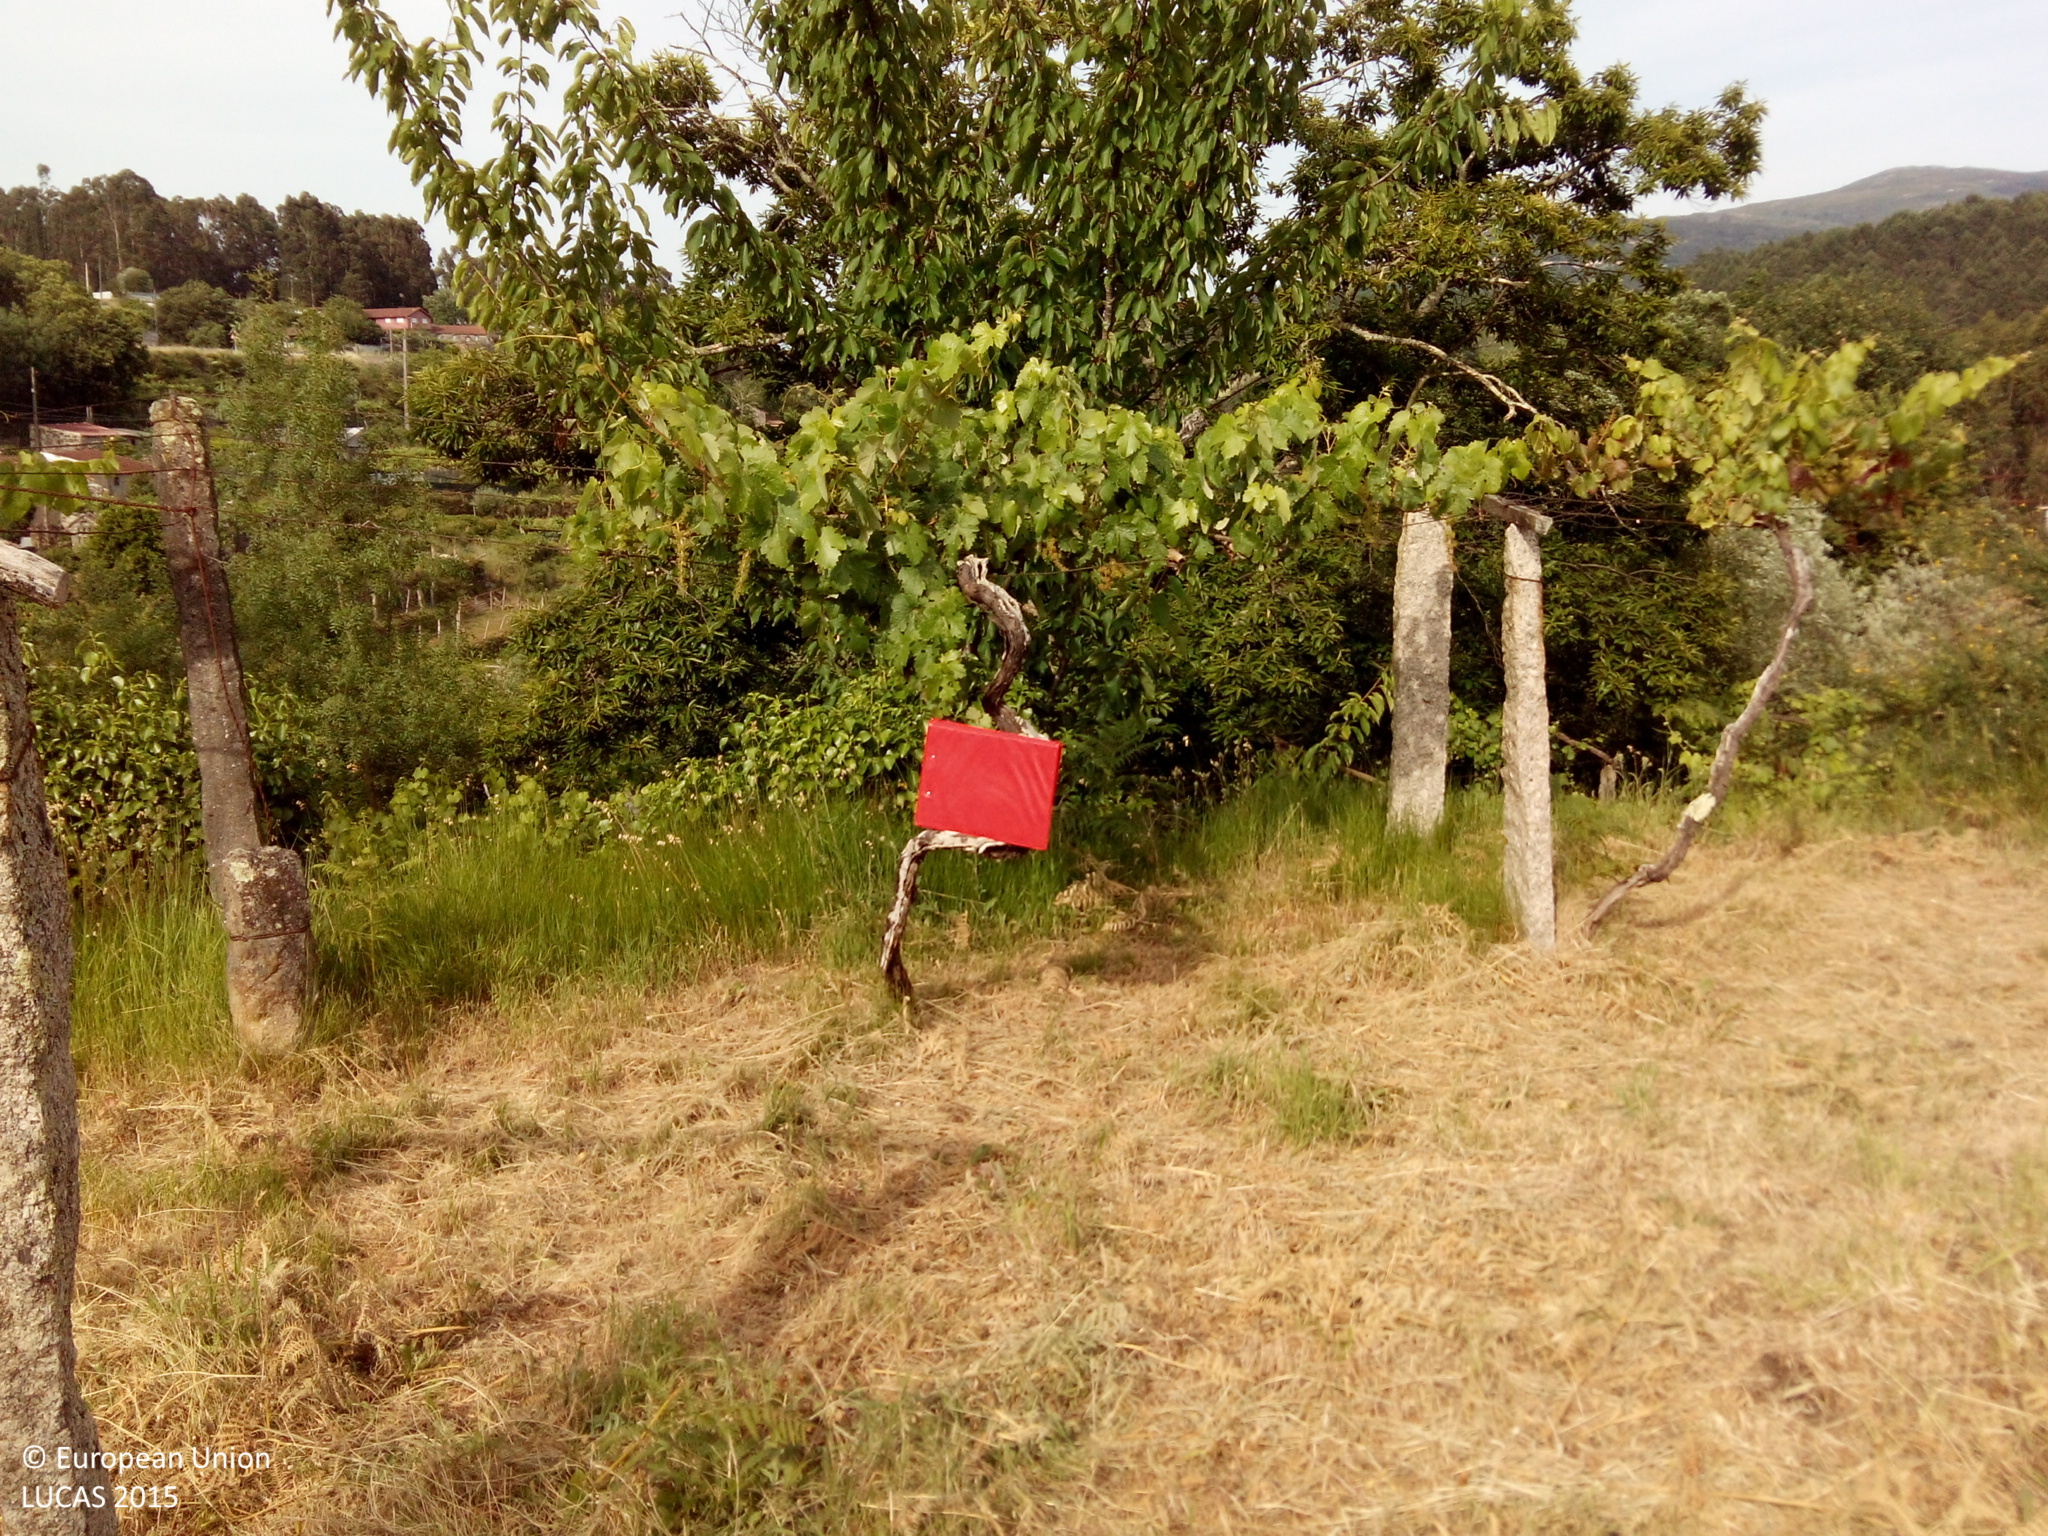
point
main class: Cropland
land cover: Vineyards
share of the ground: 50 - 75 %
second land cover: Grassland without tree/shrub cover
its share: 50 - 75 %
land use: Agriculture (excluding fallow land and kitchen gardens)
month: June
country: ES
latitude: 42.1170
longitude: -8.2893
